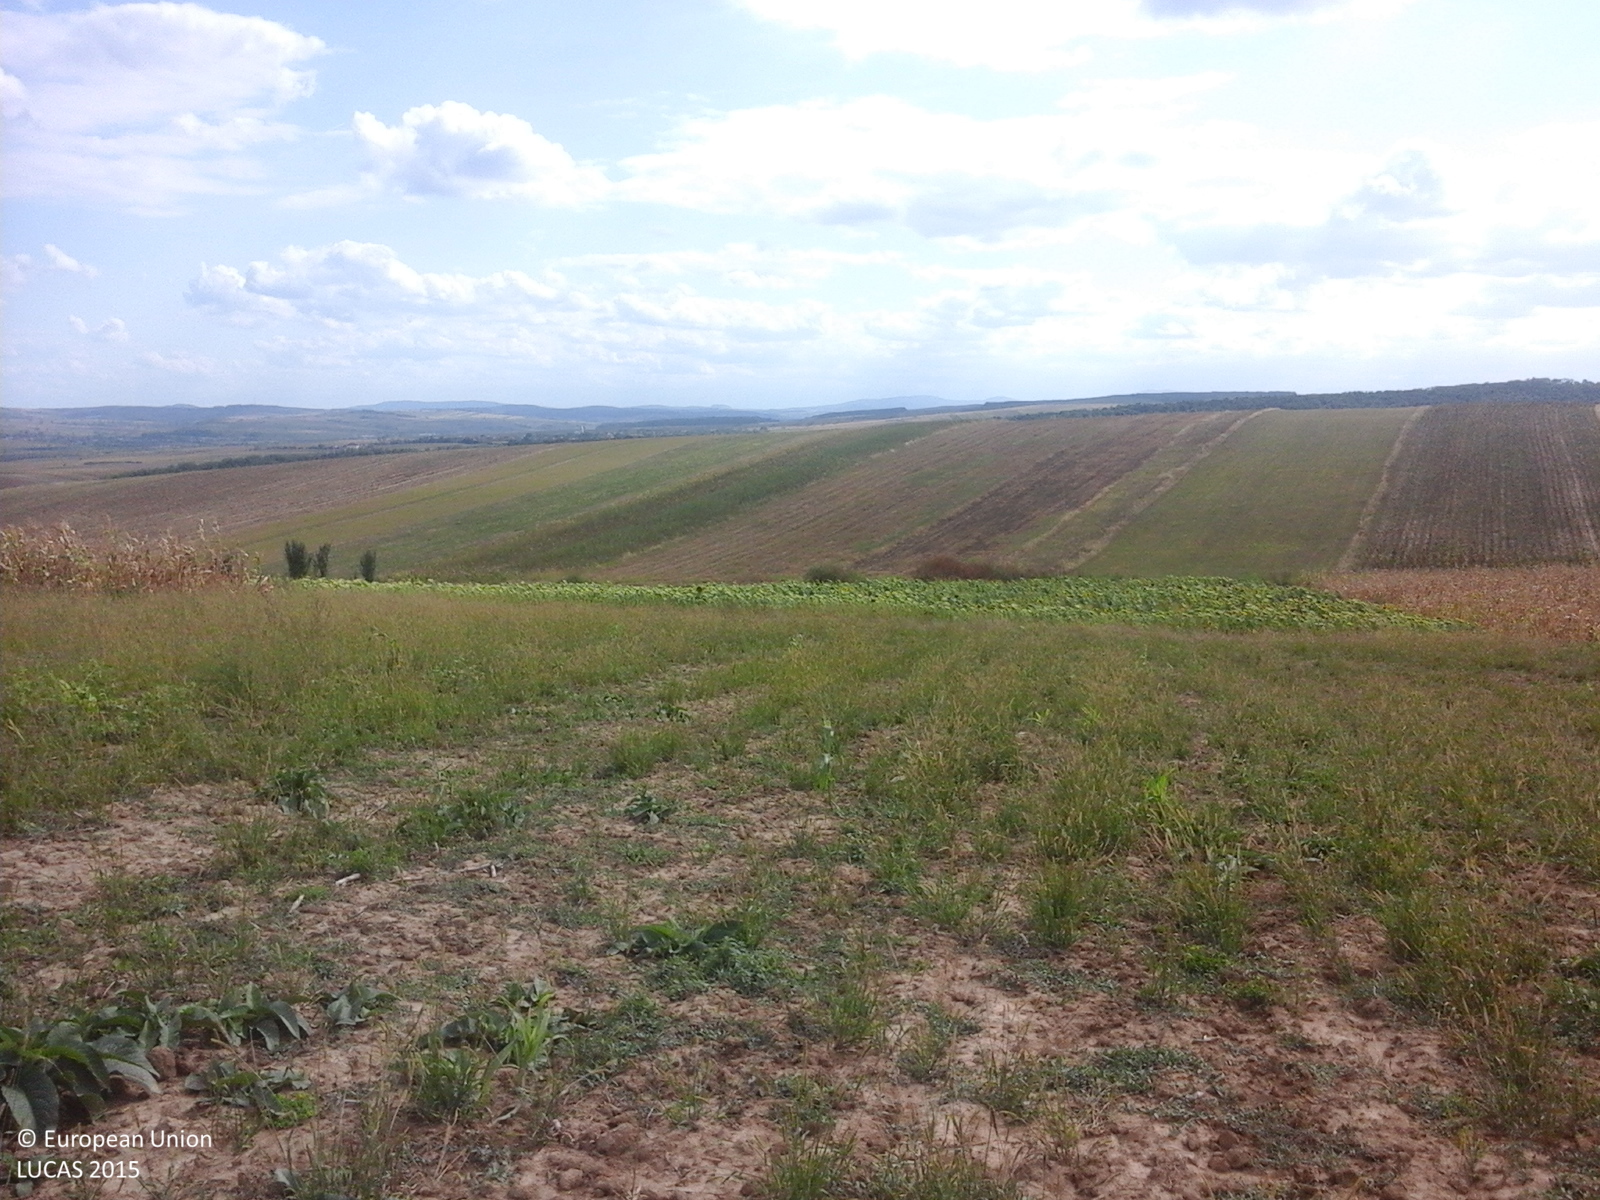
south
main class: Grassland
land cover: Spontaneously vegetated surfaces
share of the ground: > 75 %
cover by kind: herbaceous plants 100 %
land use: Fallow land
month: September
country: RO
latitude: 47.4522
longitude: 23.1313
